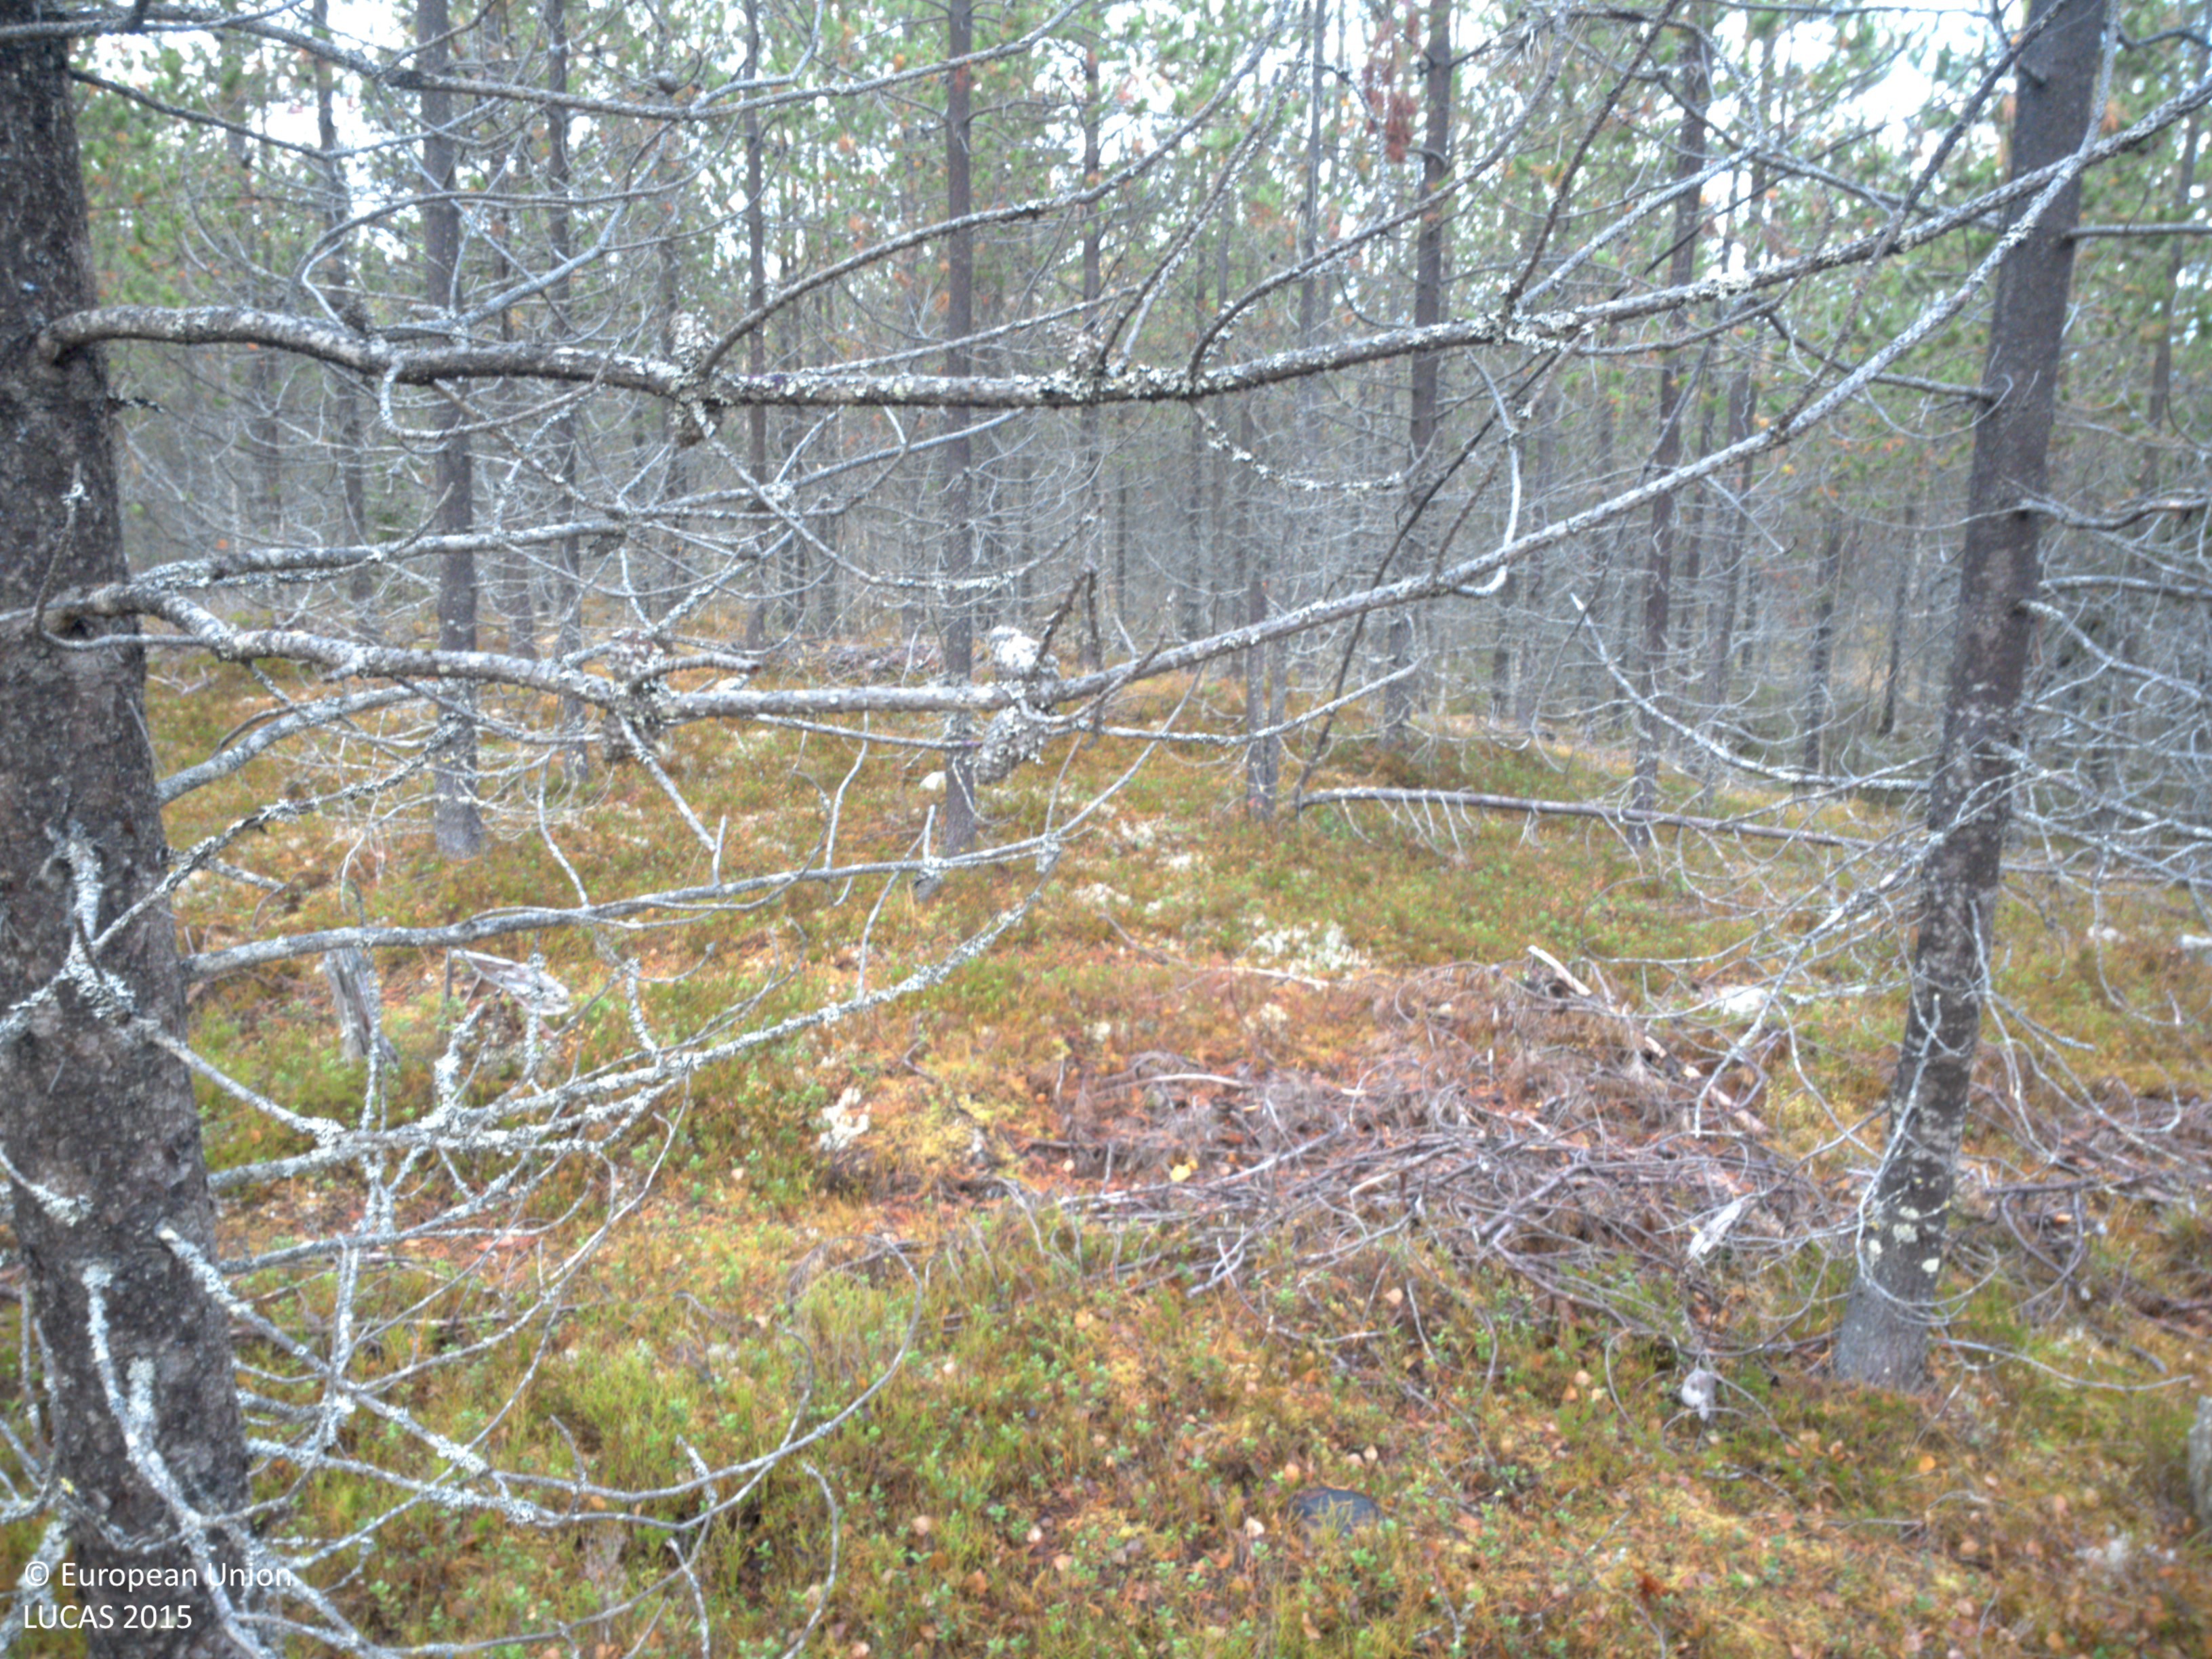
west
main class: Woodland
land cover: Pine dominated coniferous woodland
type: exotic forest
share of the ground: > 75 %
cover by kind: coniferous forest trees 75 %, shrubs 10 %, lichens and mosses 10 %, herbaceous plants 5 %
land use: Forestry
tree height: > 5 m
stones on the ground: 25 - 50 %
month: October
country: SE
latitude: 63.8268
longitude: 18.1211
